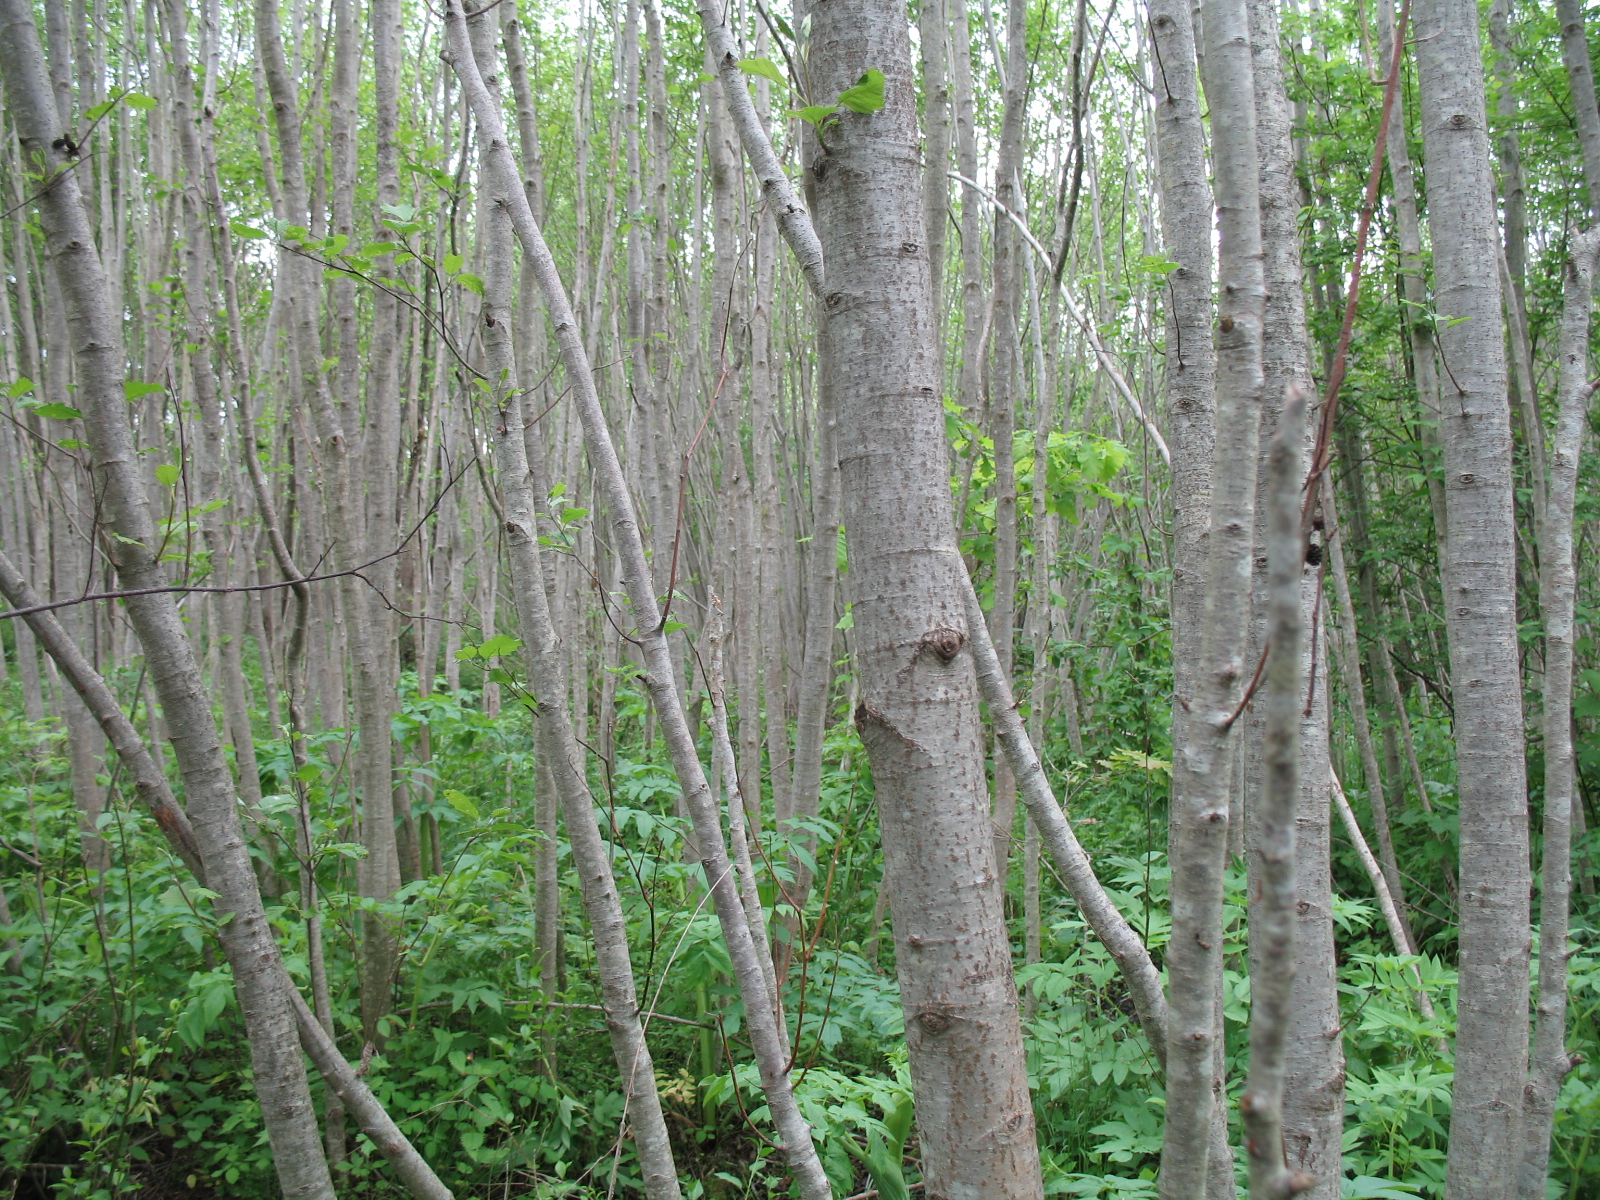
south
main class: Woodland
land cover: Broadleaved woodland
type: mire and swamp forests
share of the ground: > 75 %
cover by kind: broadleaved forest trees 95 %, herbaceous plants 5 %
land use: Forestry
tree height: > 5 m
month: May
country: LV
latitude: 56.7451
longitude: 23.5315
